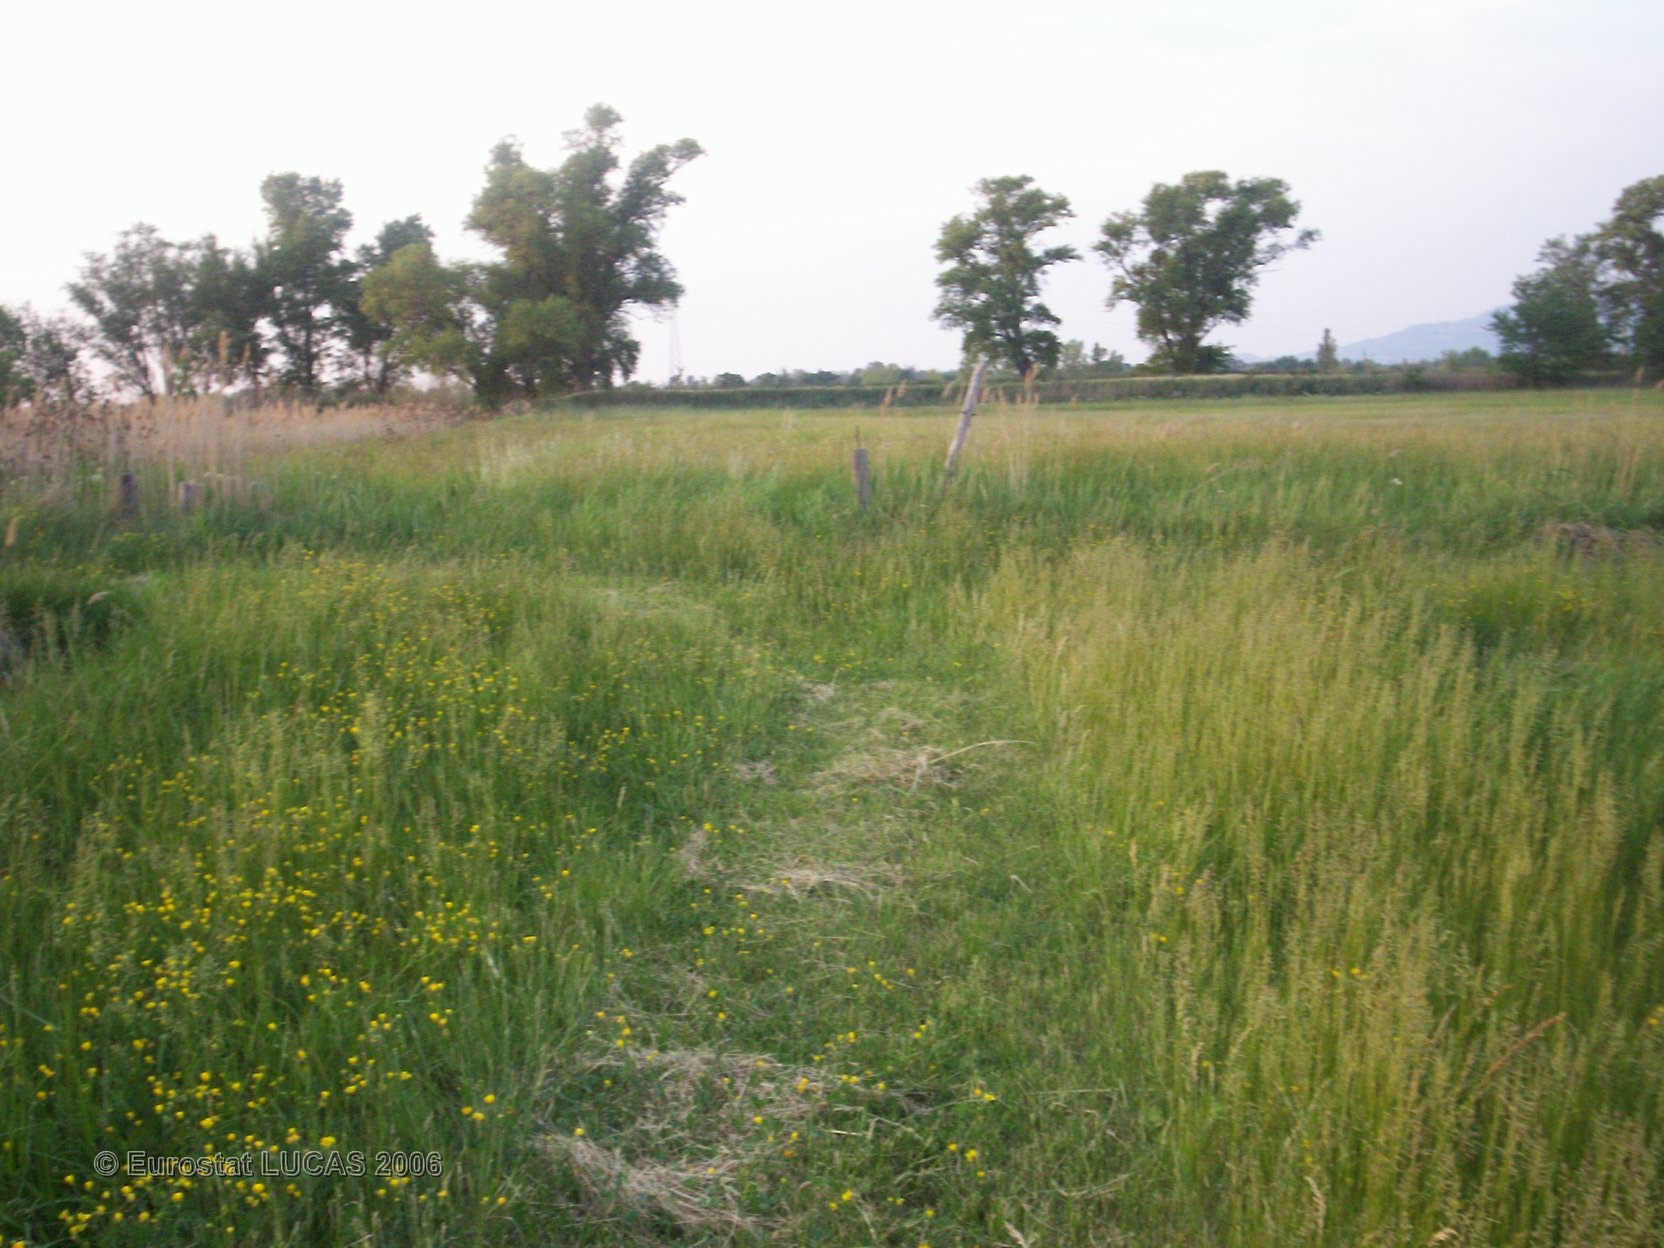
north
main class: Grassland
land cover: Grassland without tree/shrub cover
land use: Agriculture (excluding fallow land and kitchen gardens)
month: May
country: FR
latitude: 44.0471
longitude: 4.9536
